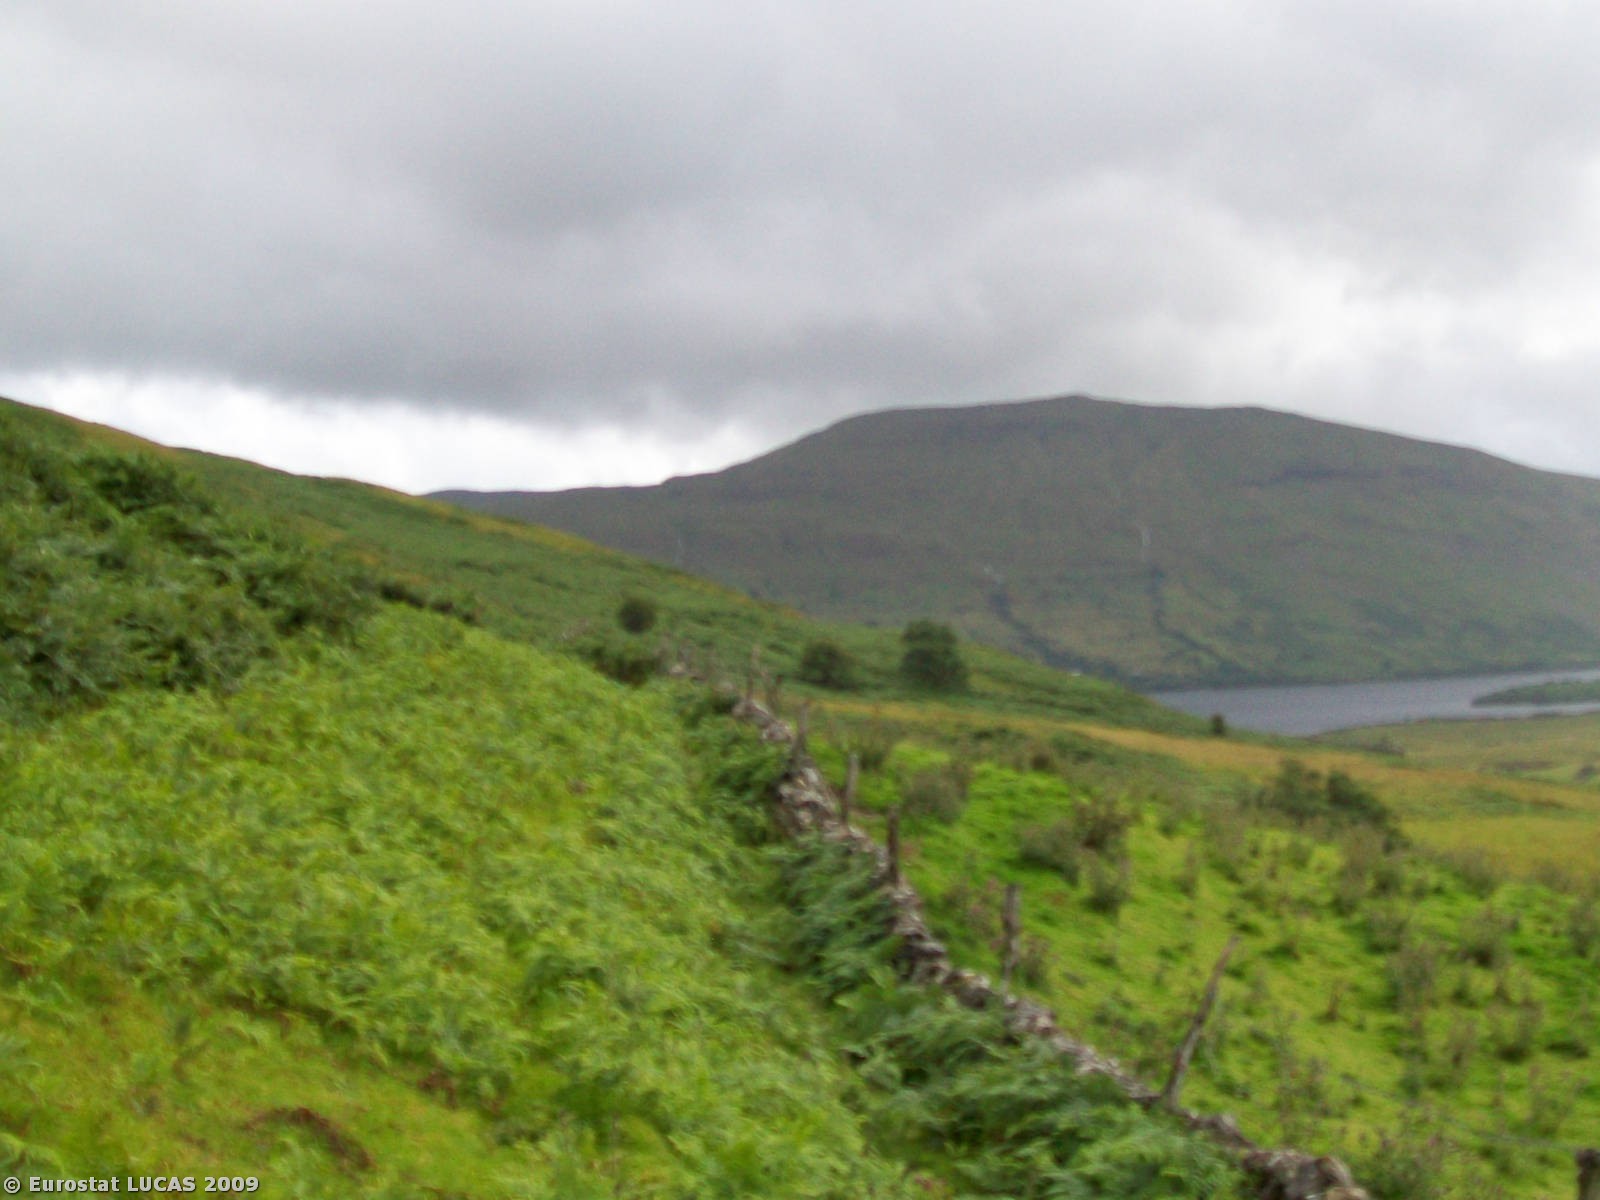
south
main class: Grassland
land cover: Grassland without tree/shrub cover
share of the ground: > 75 %
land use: Agriculture (excluding fallow land and kitchen gardens)
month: July
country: IE
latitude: 53.5749
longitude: -9.4871
